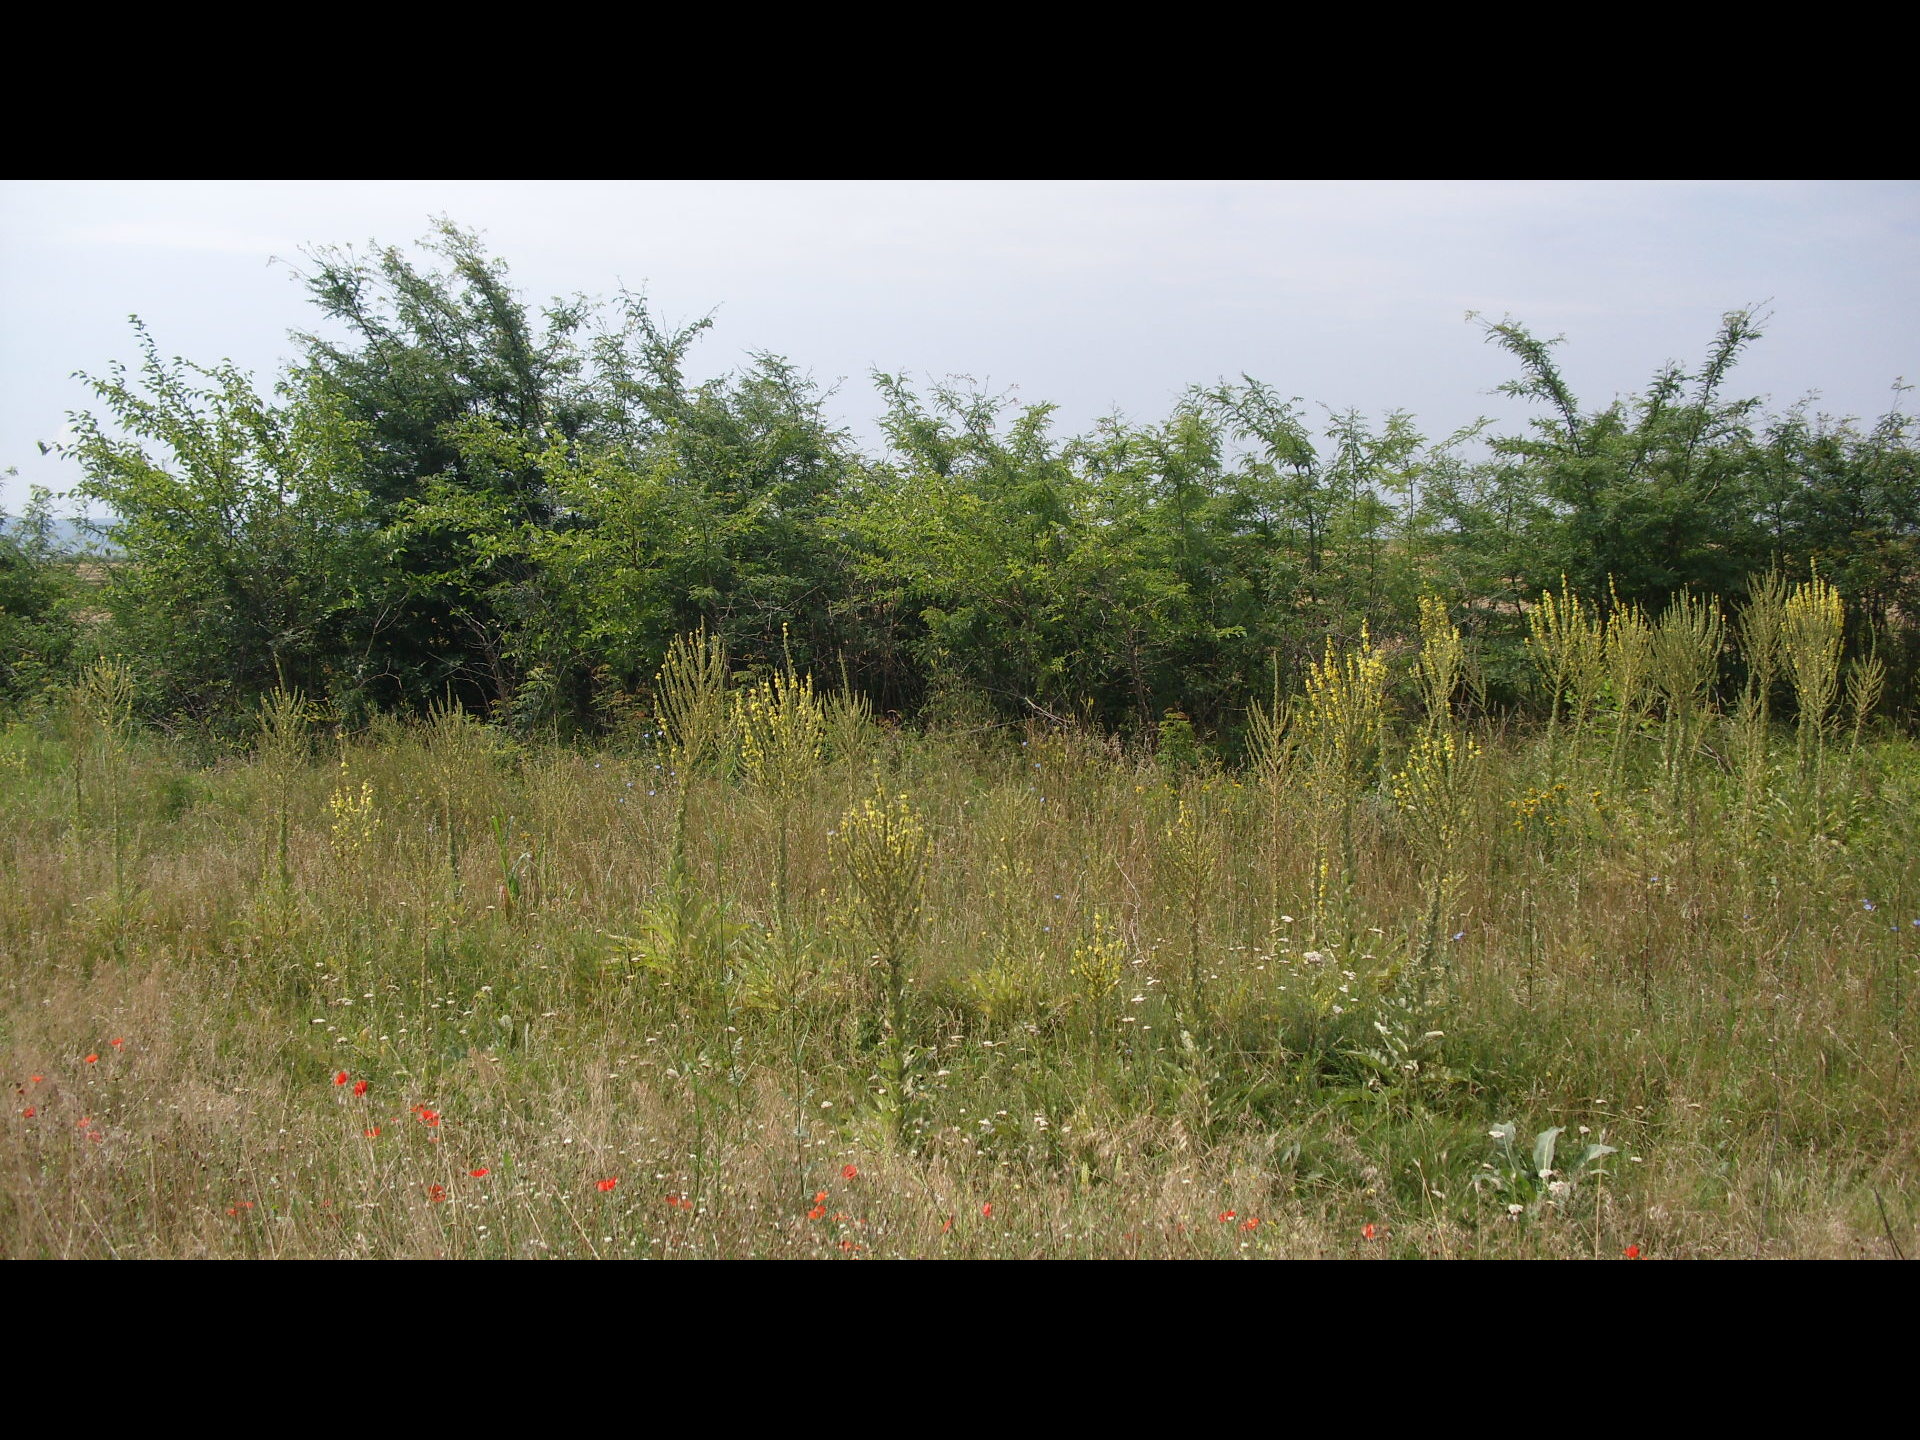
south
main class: Cropland
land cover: Sunflower
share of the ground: > 75 %
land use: Agriculture (excluding fallow land and kitchen gardens)
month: July
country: BG
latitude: 43.8124
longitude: 23.2082
